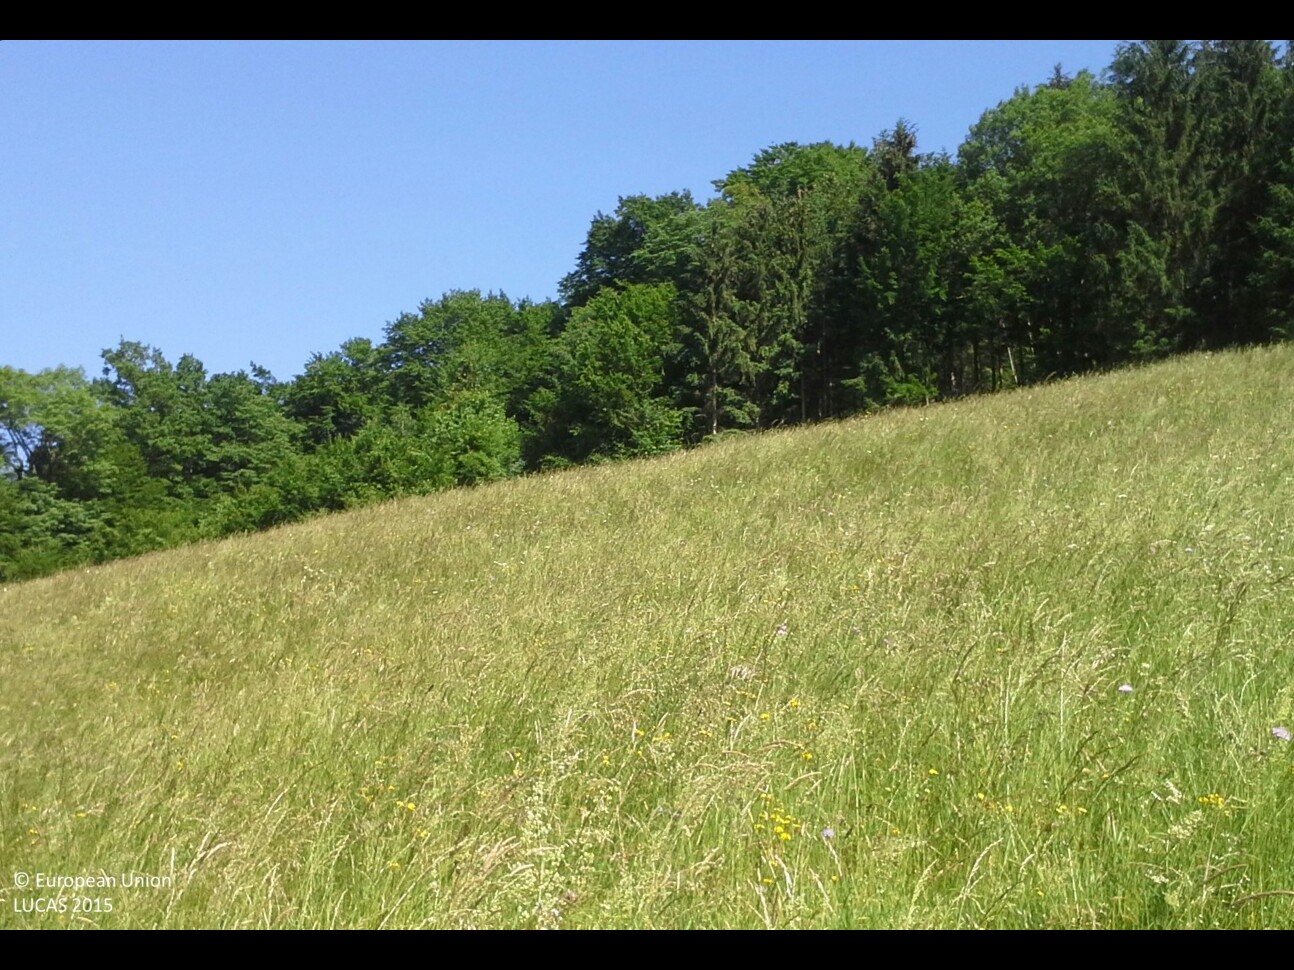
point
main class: Grassland
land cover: Grassland without tree/shrub cover
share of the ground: > 75 %
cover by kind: herbaceous plants 100 %
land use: Agriculture (excluding fallow land and kitchen gardens)
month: June
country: AT
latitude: 47.8982
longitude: 14.4809
